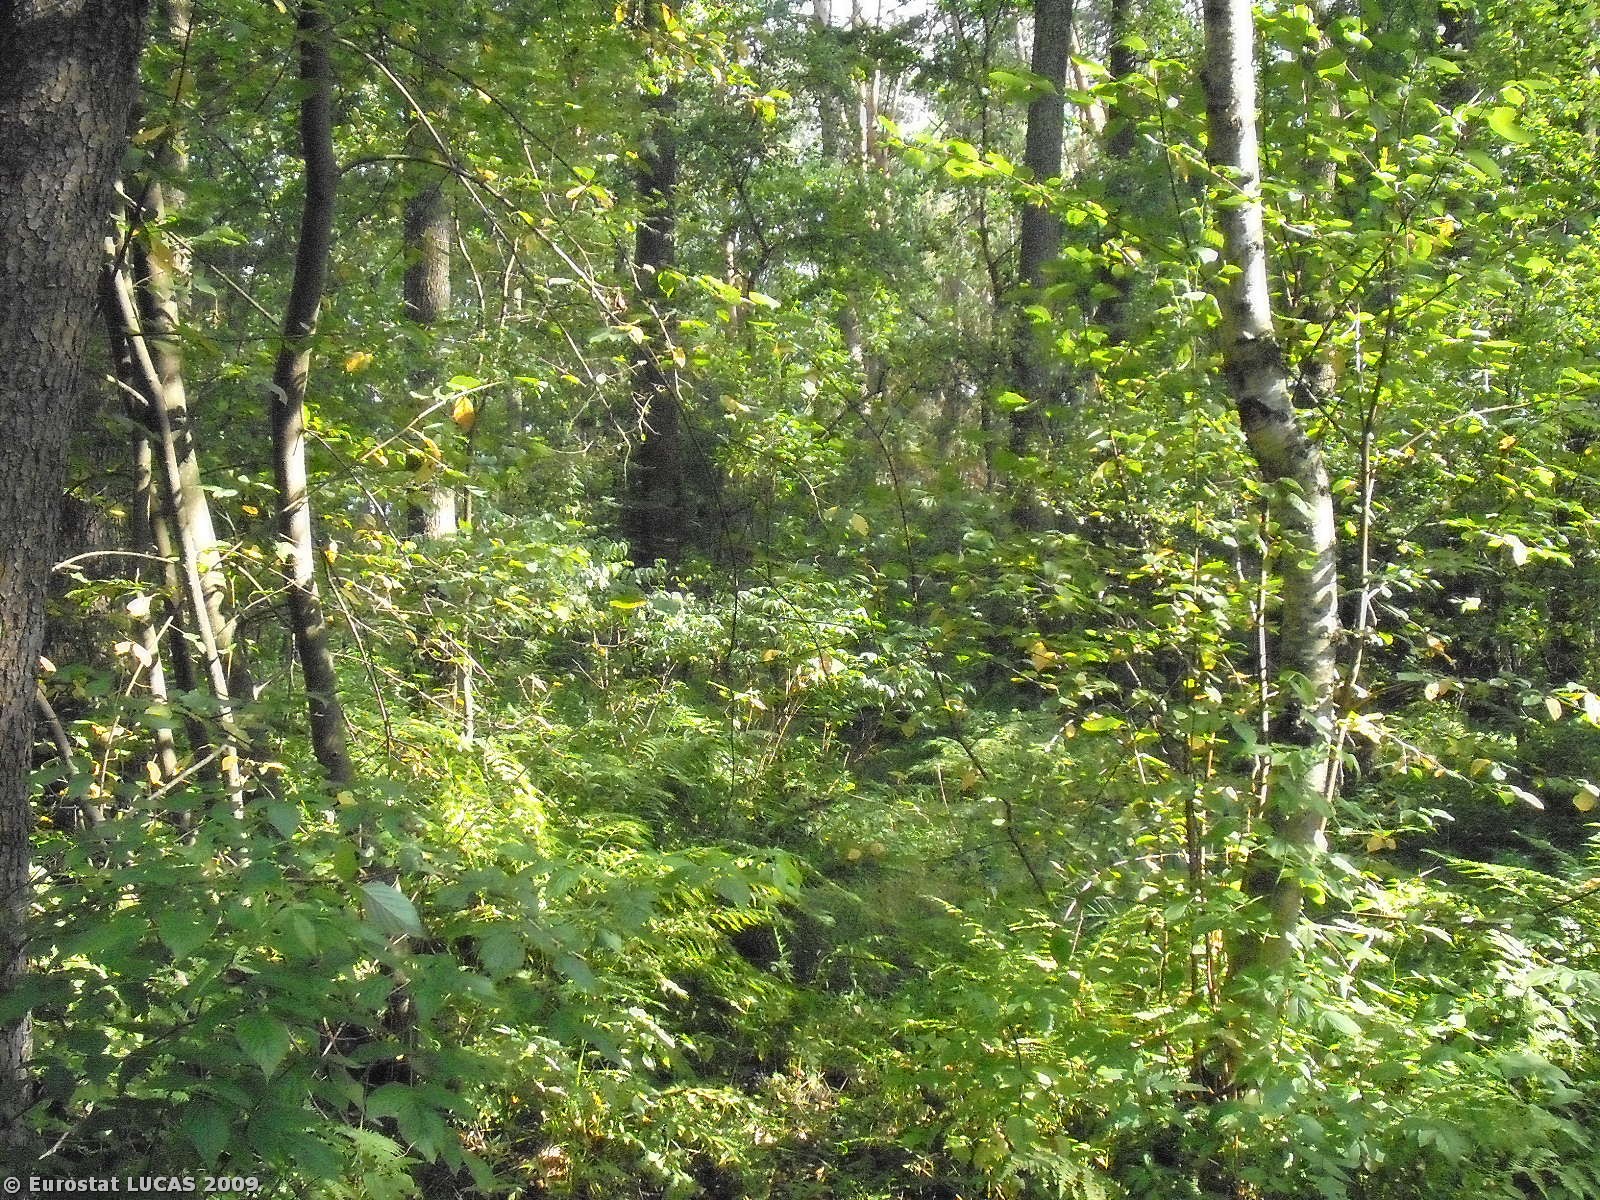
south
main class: Woodland
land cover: Mixed woodland
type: mesophytic deciduous forest
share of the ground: > 75 %
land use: Forestry
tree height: > 5 m
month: July
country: PL
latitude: 50.7174
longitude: 20.8492
